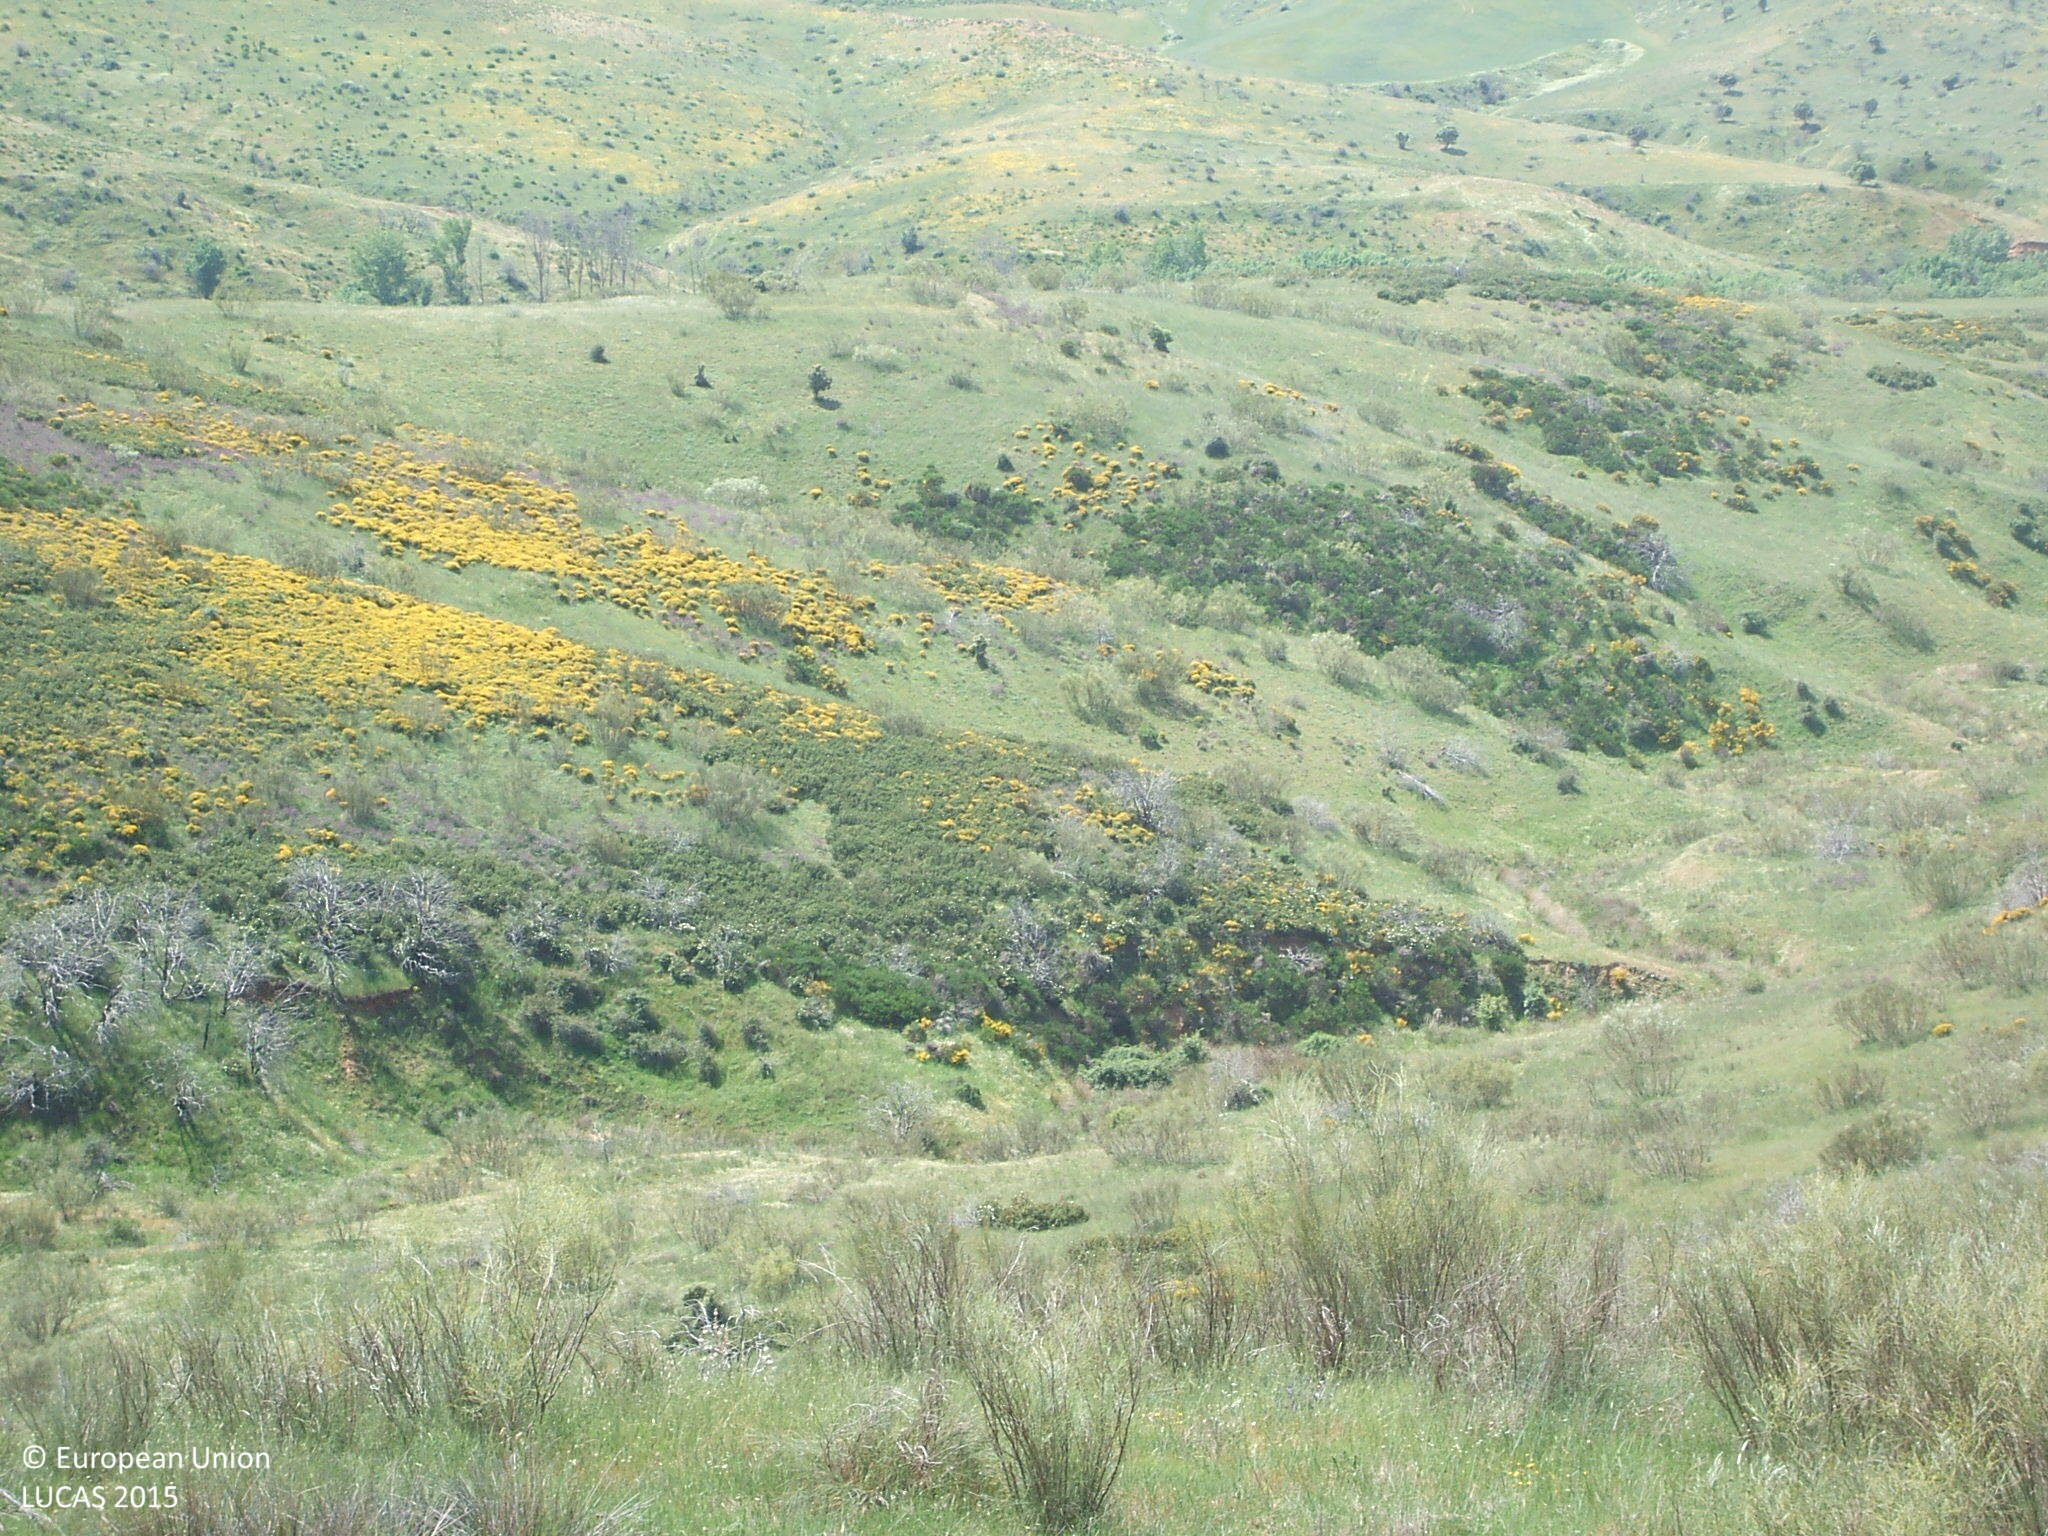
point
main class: Shrubland
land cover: Shrubland without tree cover
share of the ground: > 75 %
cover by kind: shrubs 85 %, herbaceous plants 10 %, consolidated bare surface 5 %
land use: Semi-natural and natural areas not in use
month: May
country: ES
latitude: 40.8197
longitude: -3.4487
